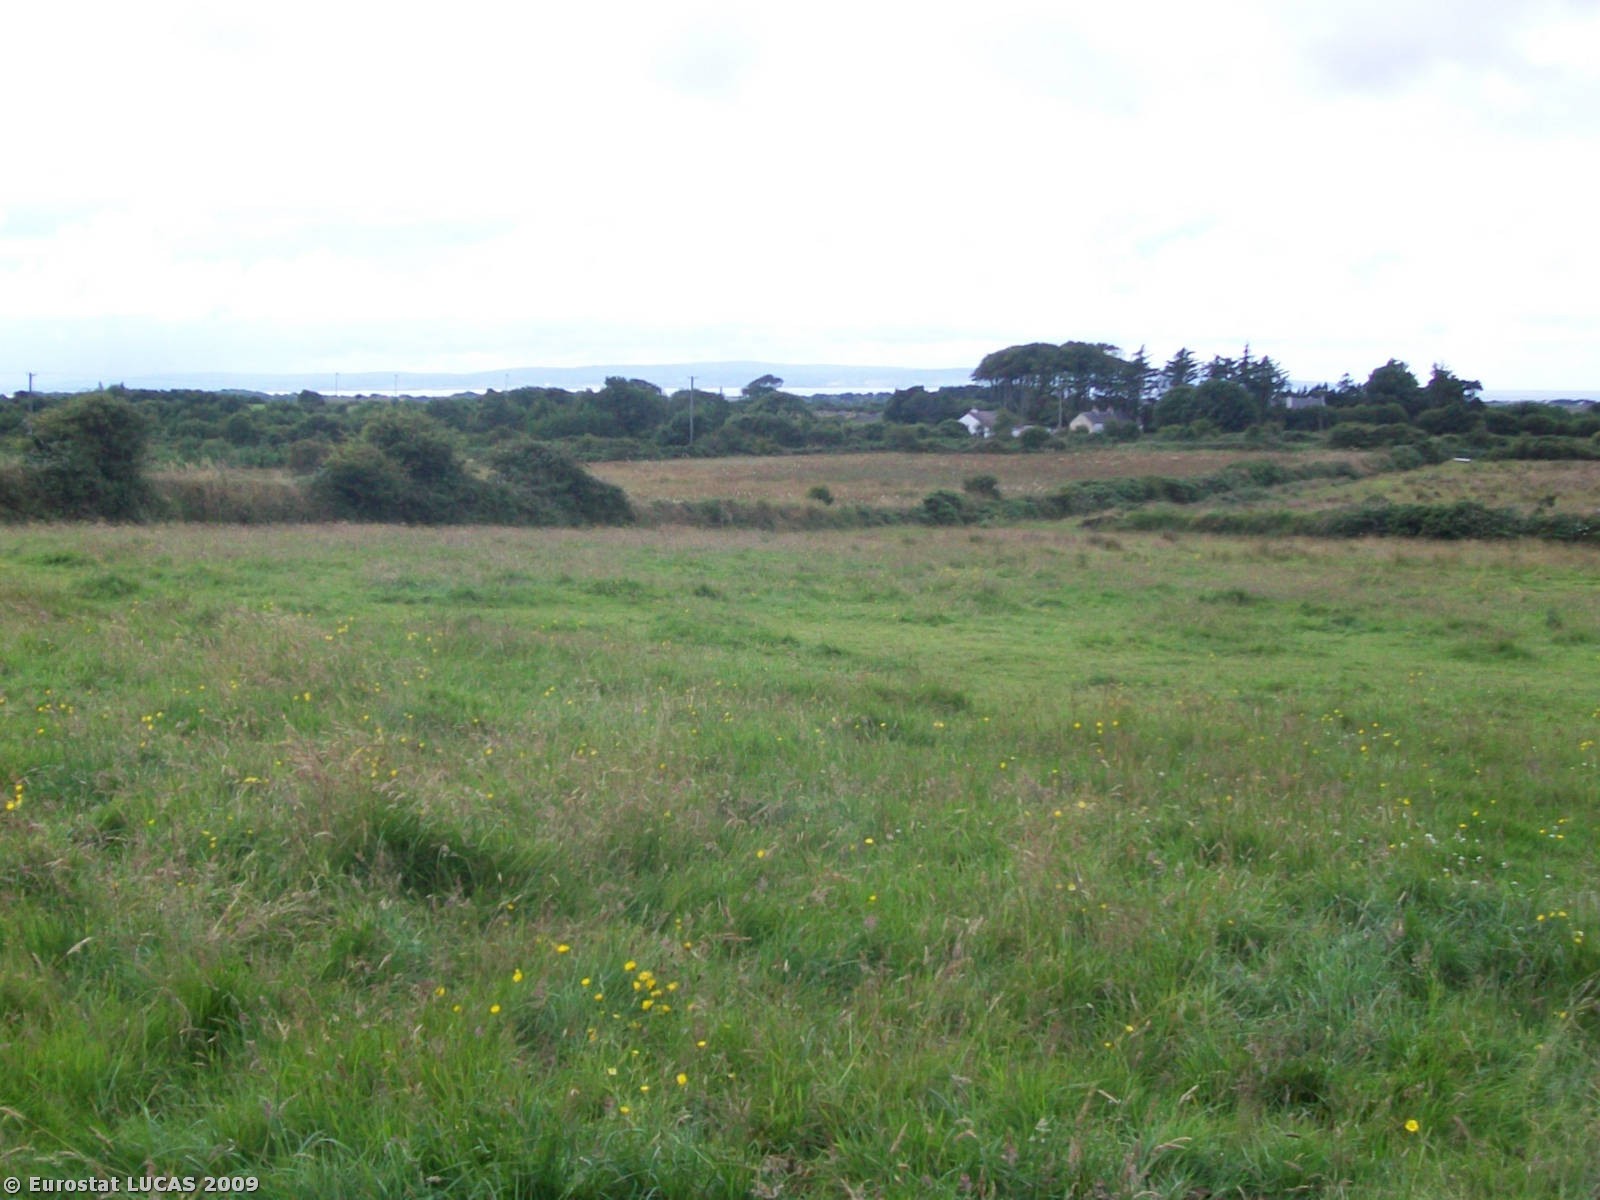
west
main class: Grassland
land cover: Grassland without tree/shrub cover
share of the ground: > 75 %
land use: Agriculture (excluding fallow land and kitchen gardens)
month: July
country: IE
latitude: 54.2495
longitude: -8.9804
